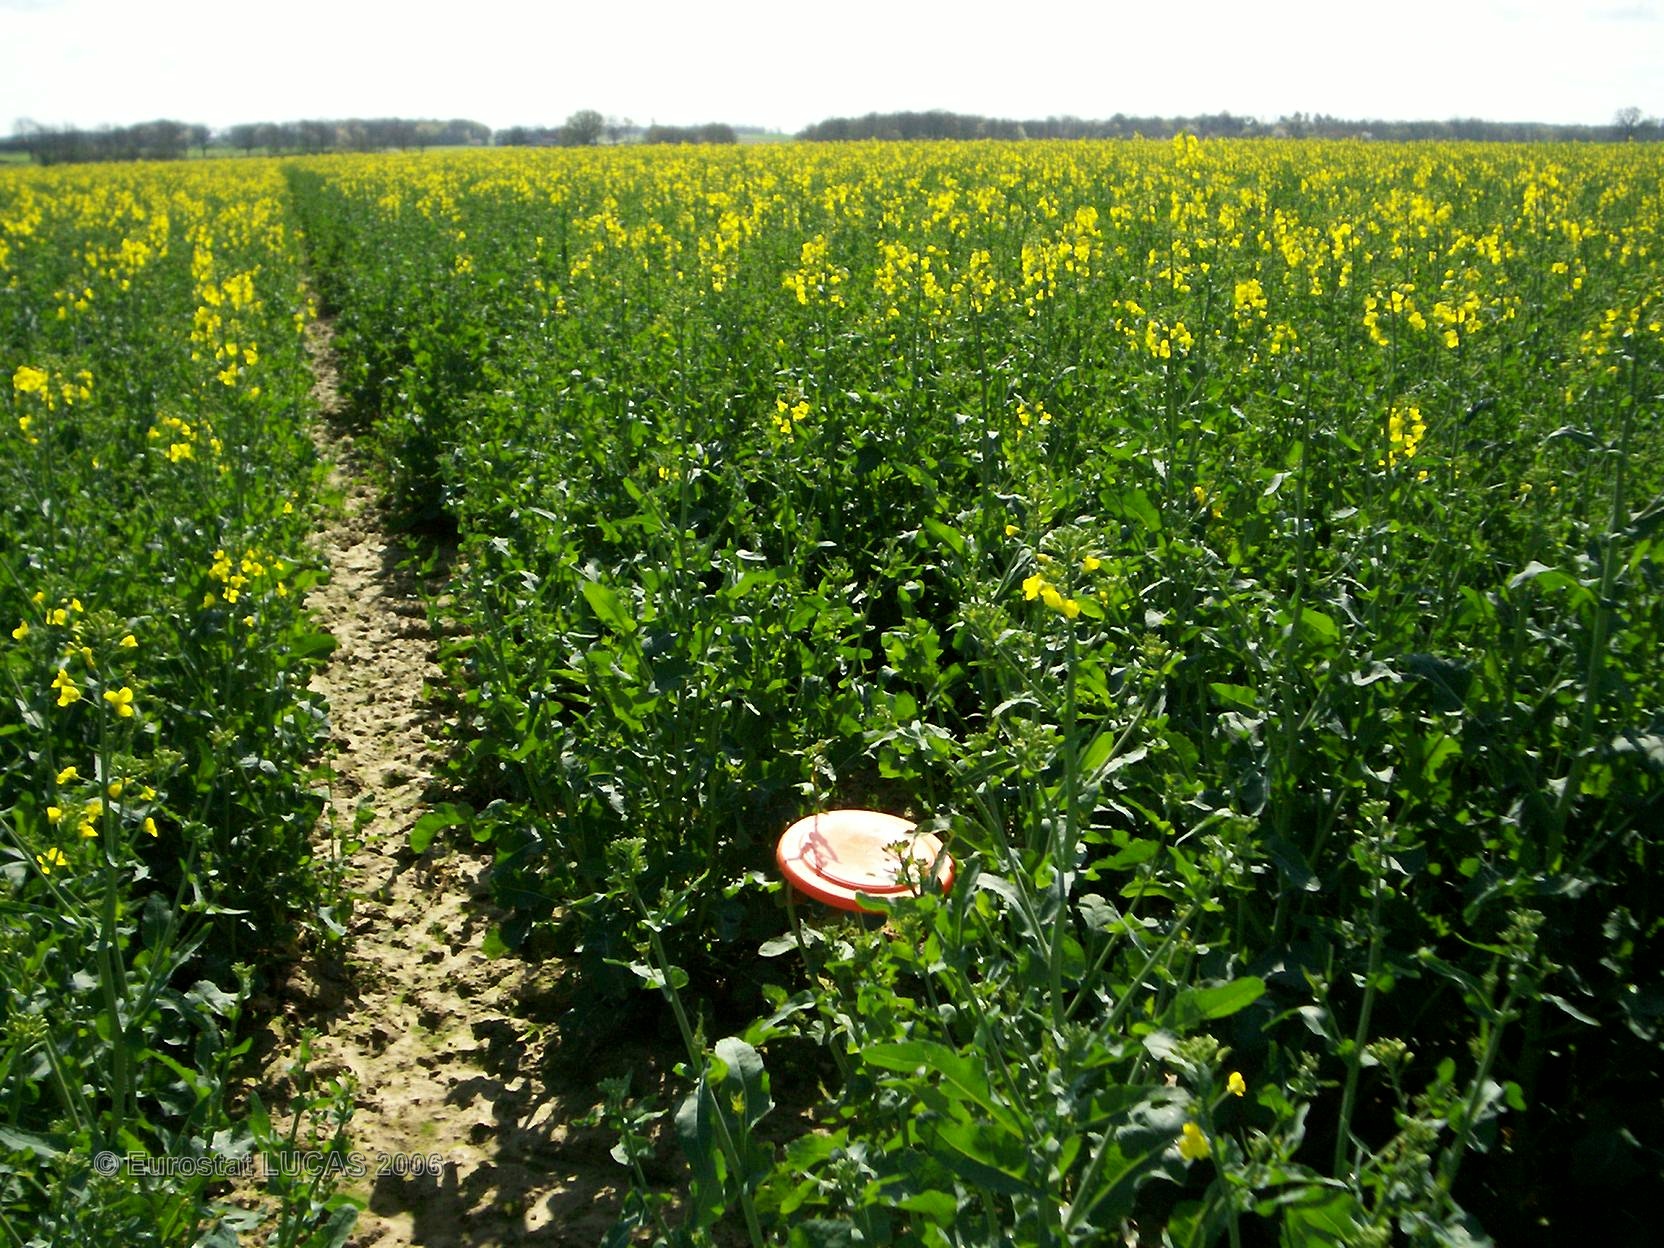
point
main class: Cropland
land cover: Rape and turnip rape
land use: Agriculture (excluding fallow land and kitchen gardens)
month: April
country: FR
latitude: 47.0017
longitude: 0.9754
